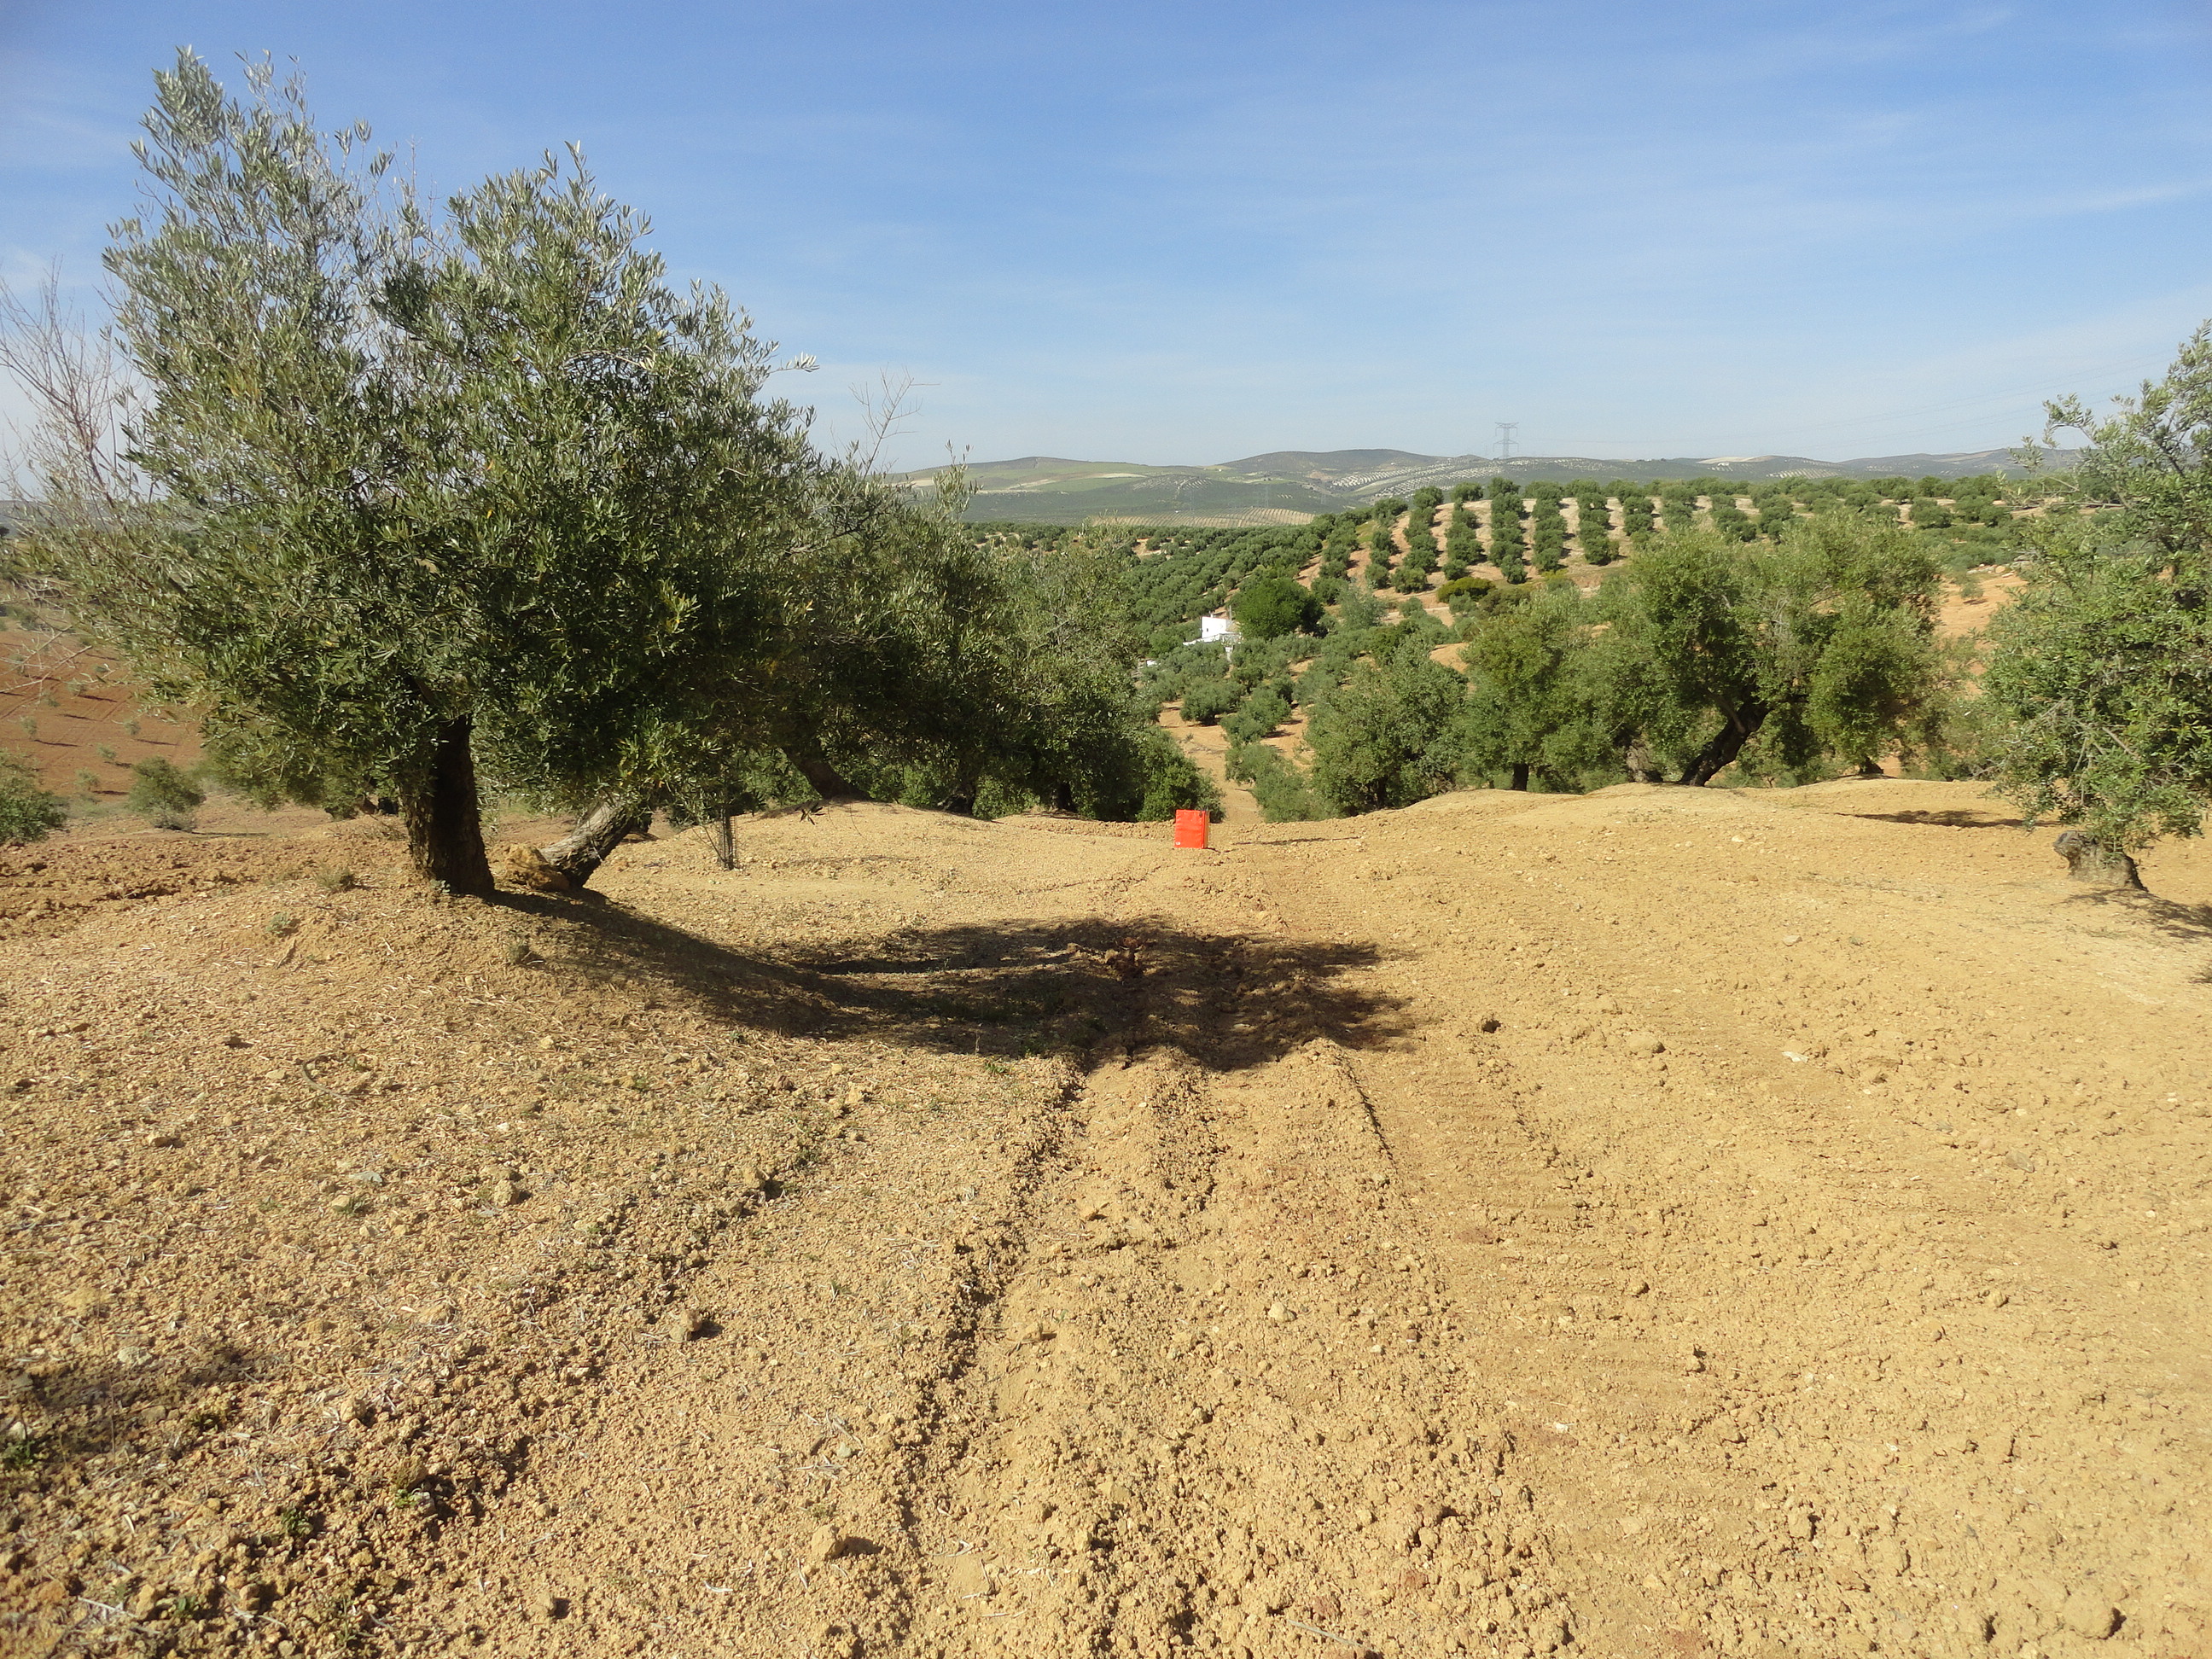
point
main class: Cropland
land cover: Olive groves
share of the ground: 25 - 50 %
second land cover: Other bare soil
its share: > 75 %
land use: Agriculture (excluding fallow land and kitchen gardens)
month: April
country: ES
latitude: 37.6545
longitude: -4.4125
